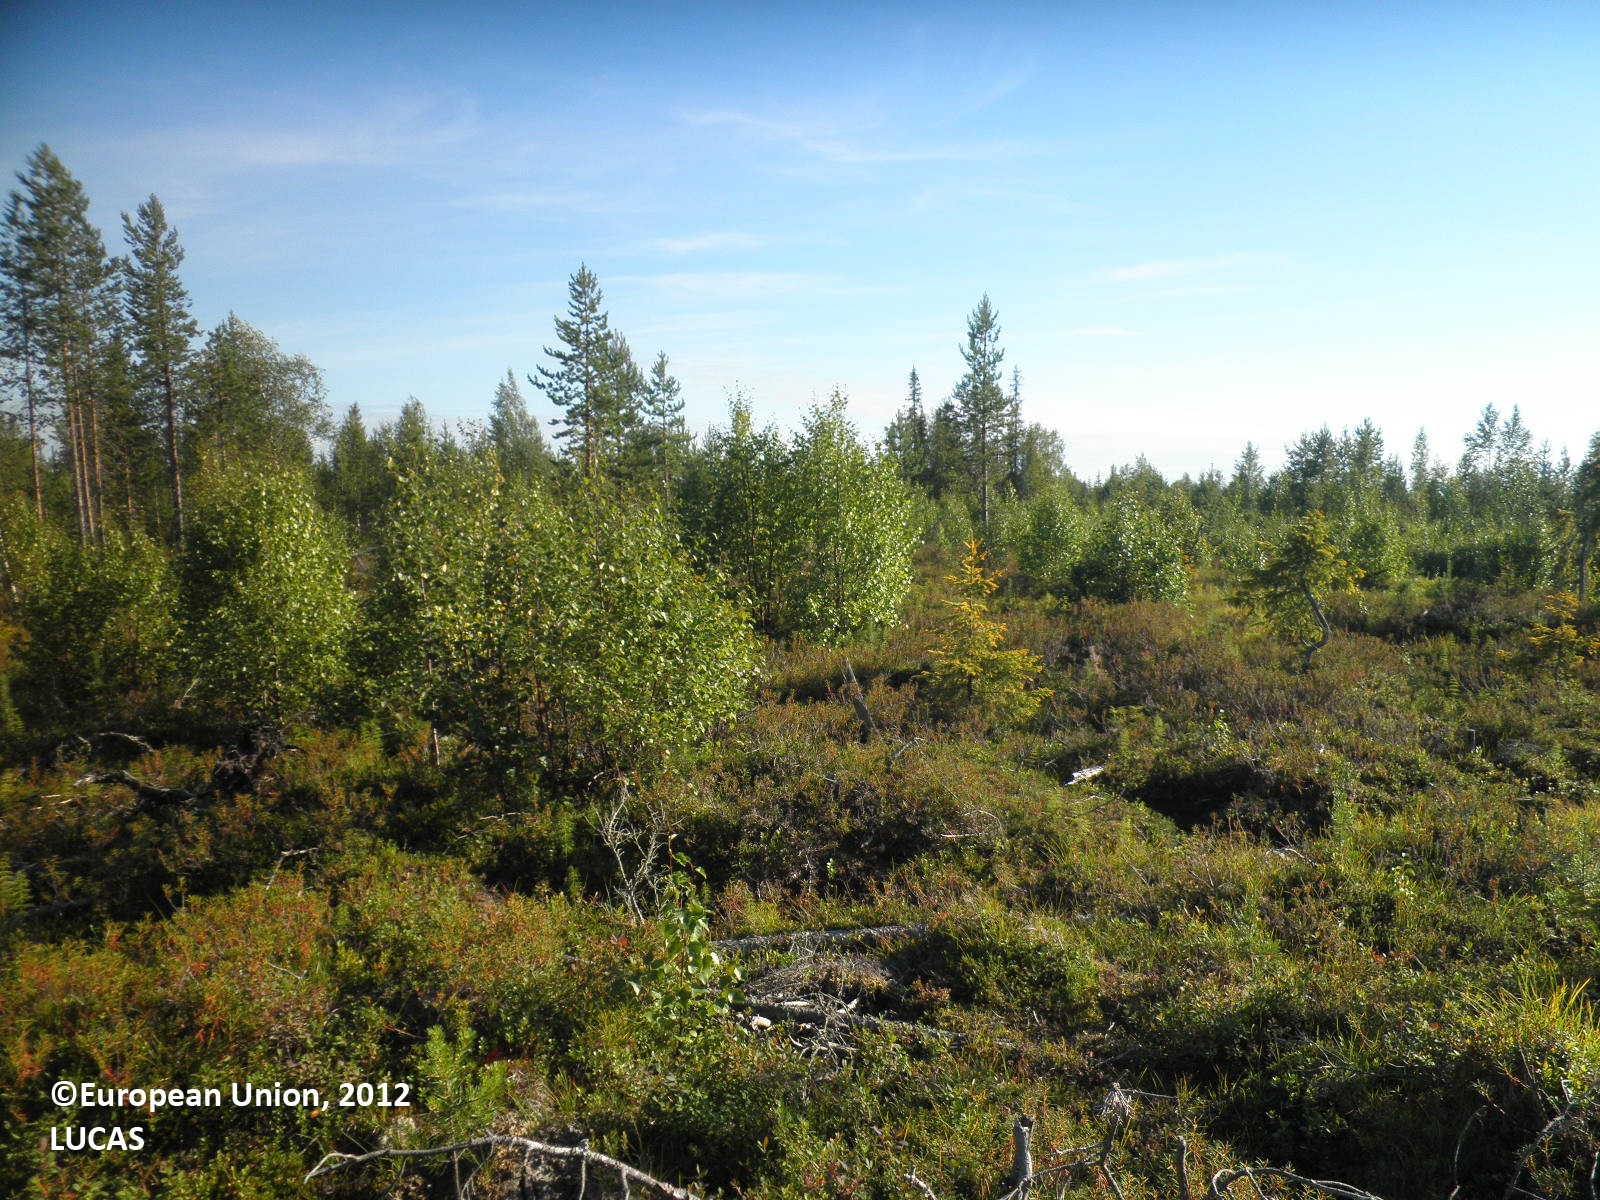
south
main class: Woodland
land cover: Pine dominated mixed woodland
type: boreal forest
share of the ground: 25 - 50 %
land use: Forestry
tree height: < 5 m
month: August
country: FI
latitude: 67.6348
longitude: 27.0630
